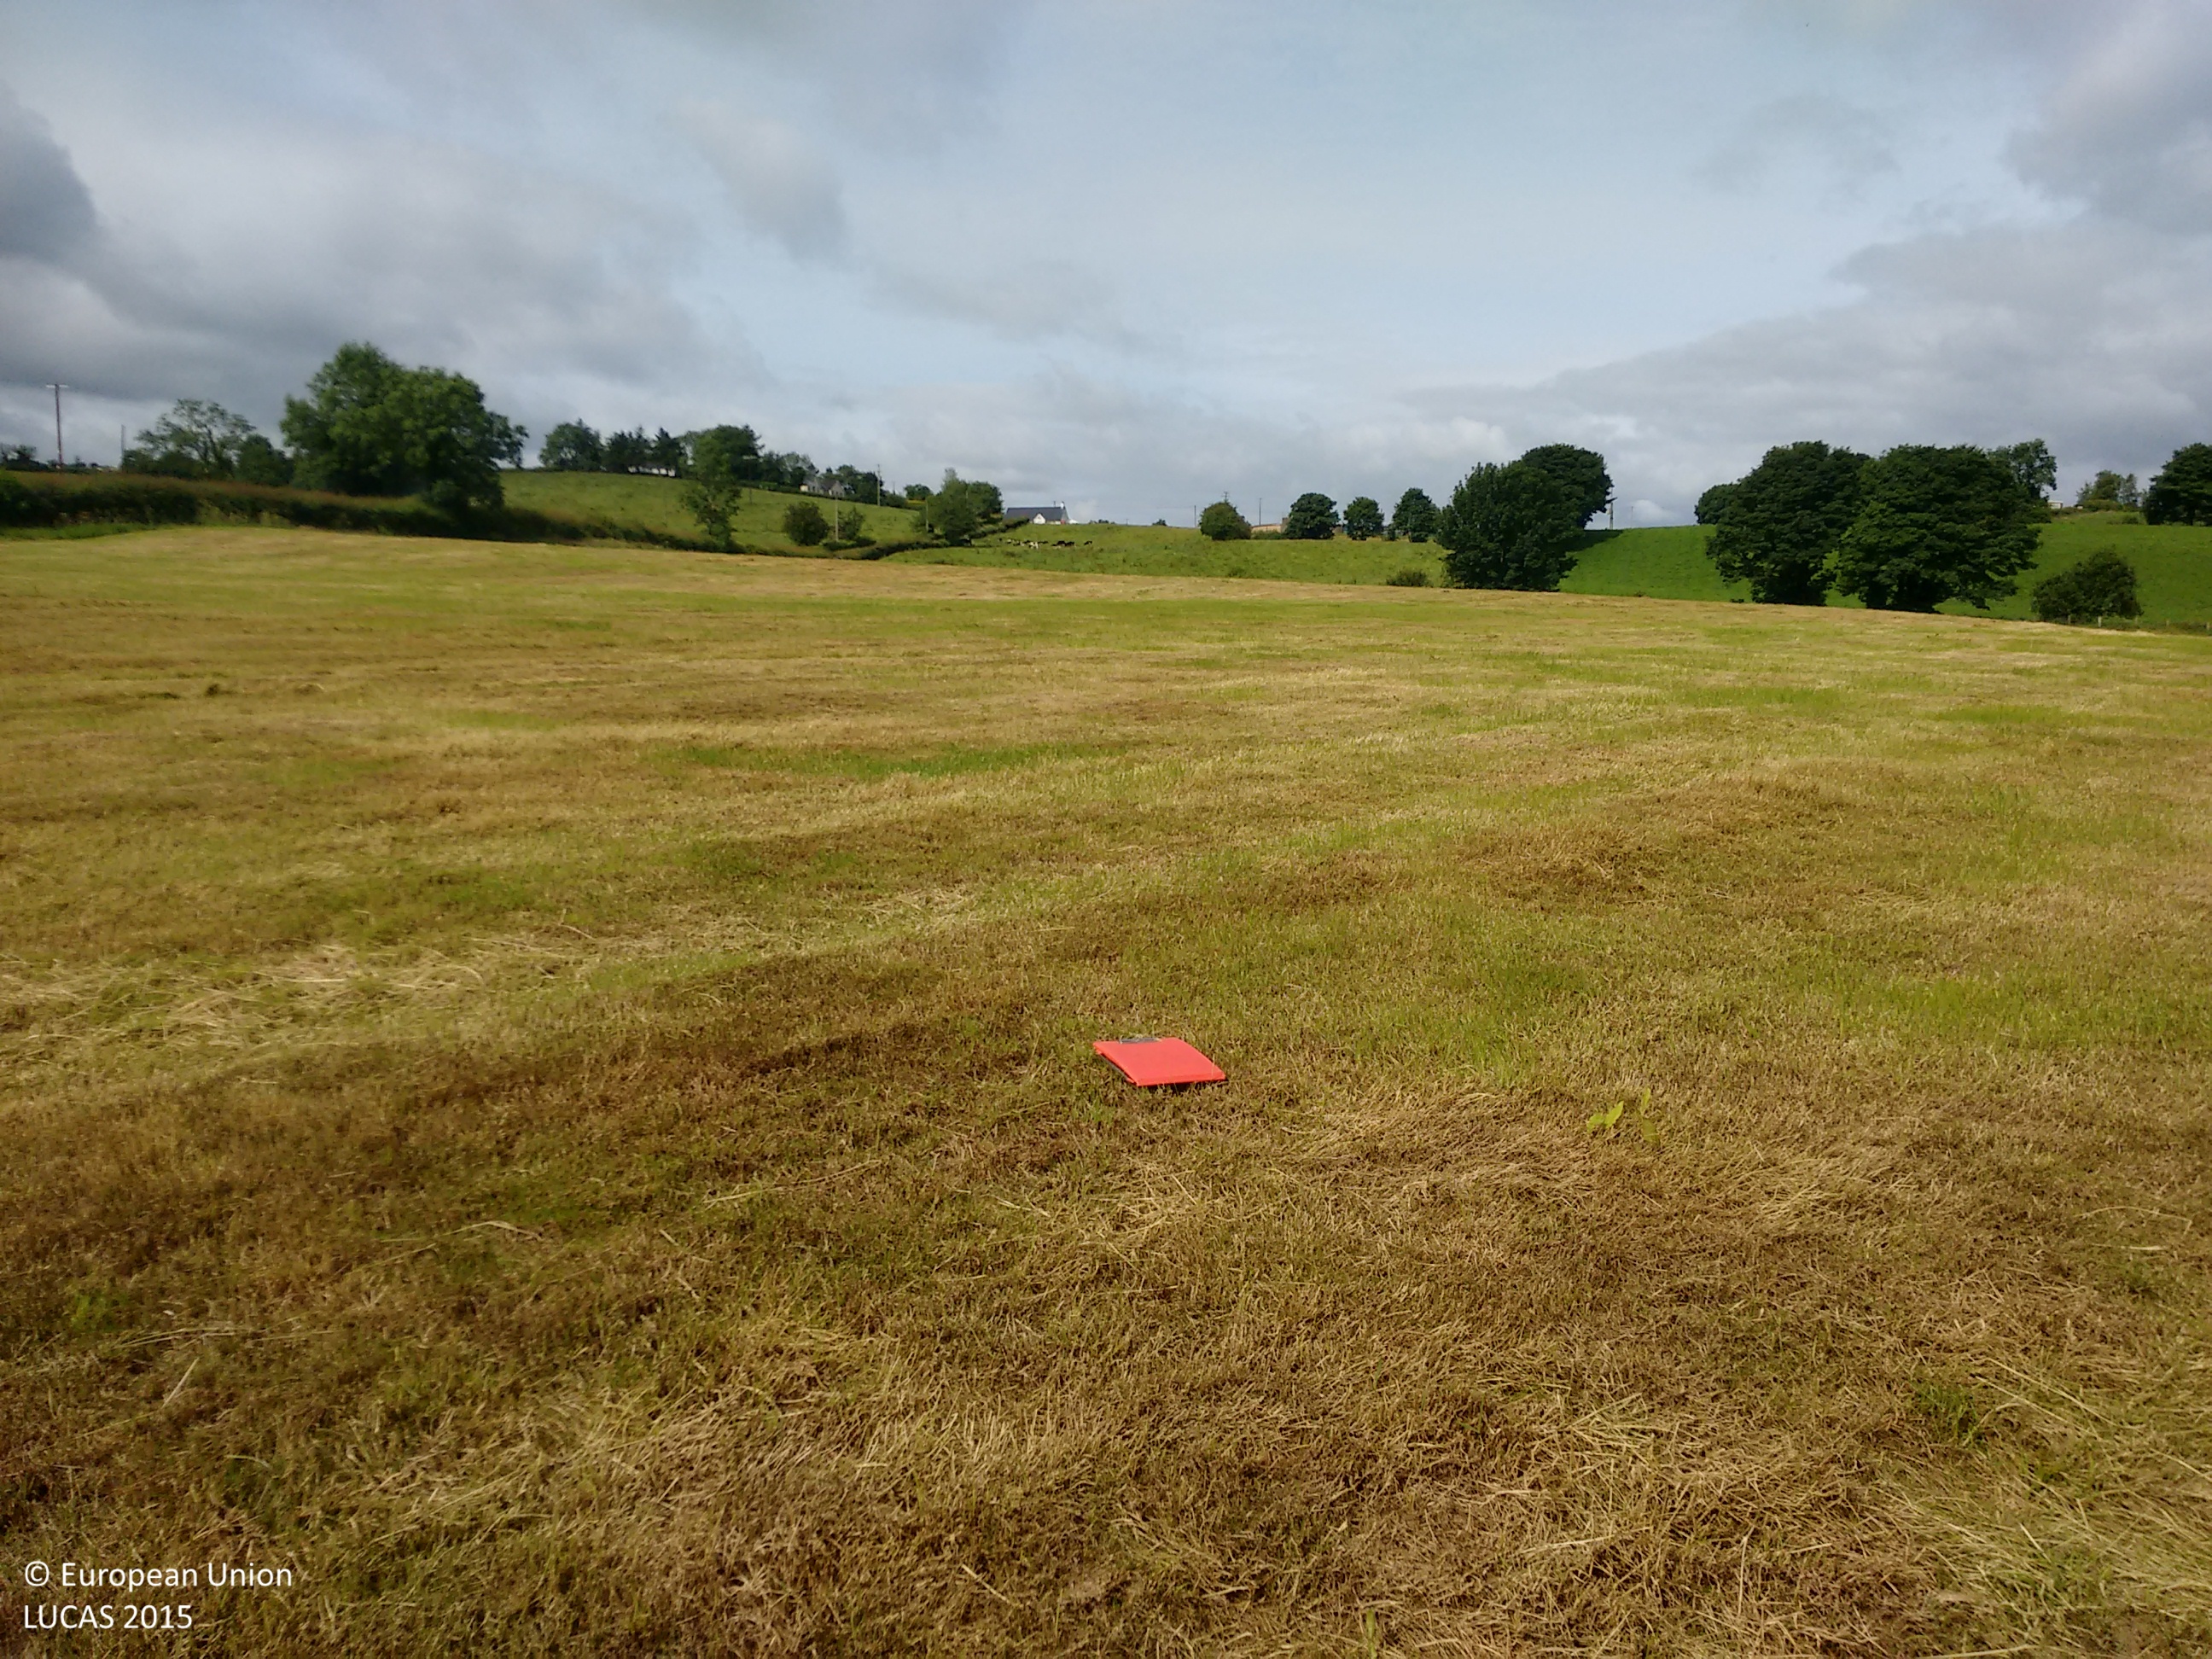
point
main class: Grassland
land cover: Grassland without tree/shrub cover
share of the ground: > 75 %
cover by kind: herbaceous plants 100 %
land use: Agriculture (excluding fallow land and kitchen gardens)
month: July
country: GB
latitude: 54.6001
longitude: -7.3799
